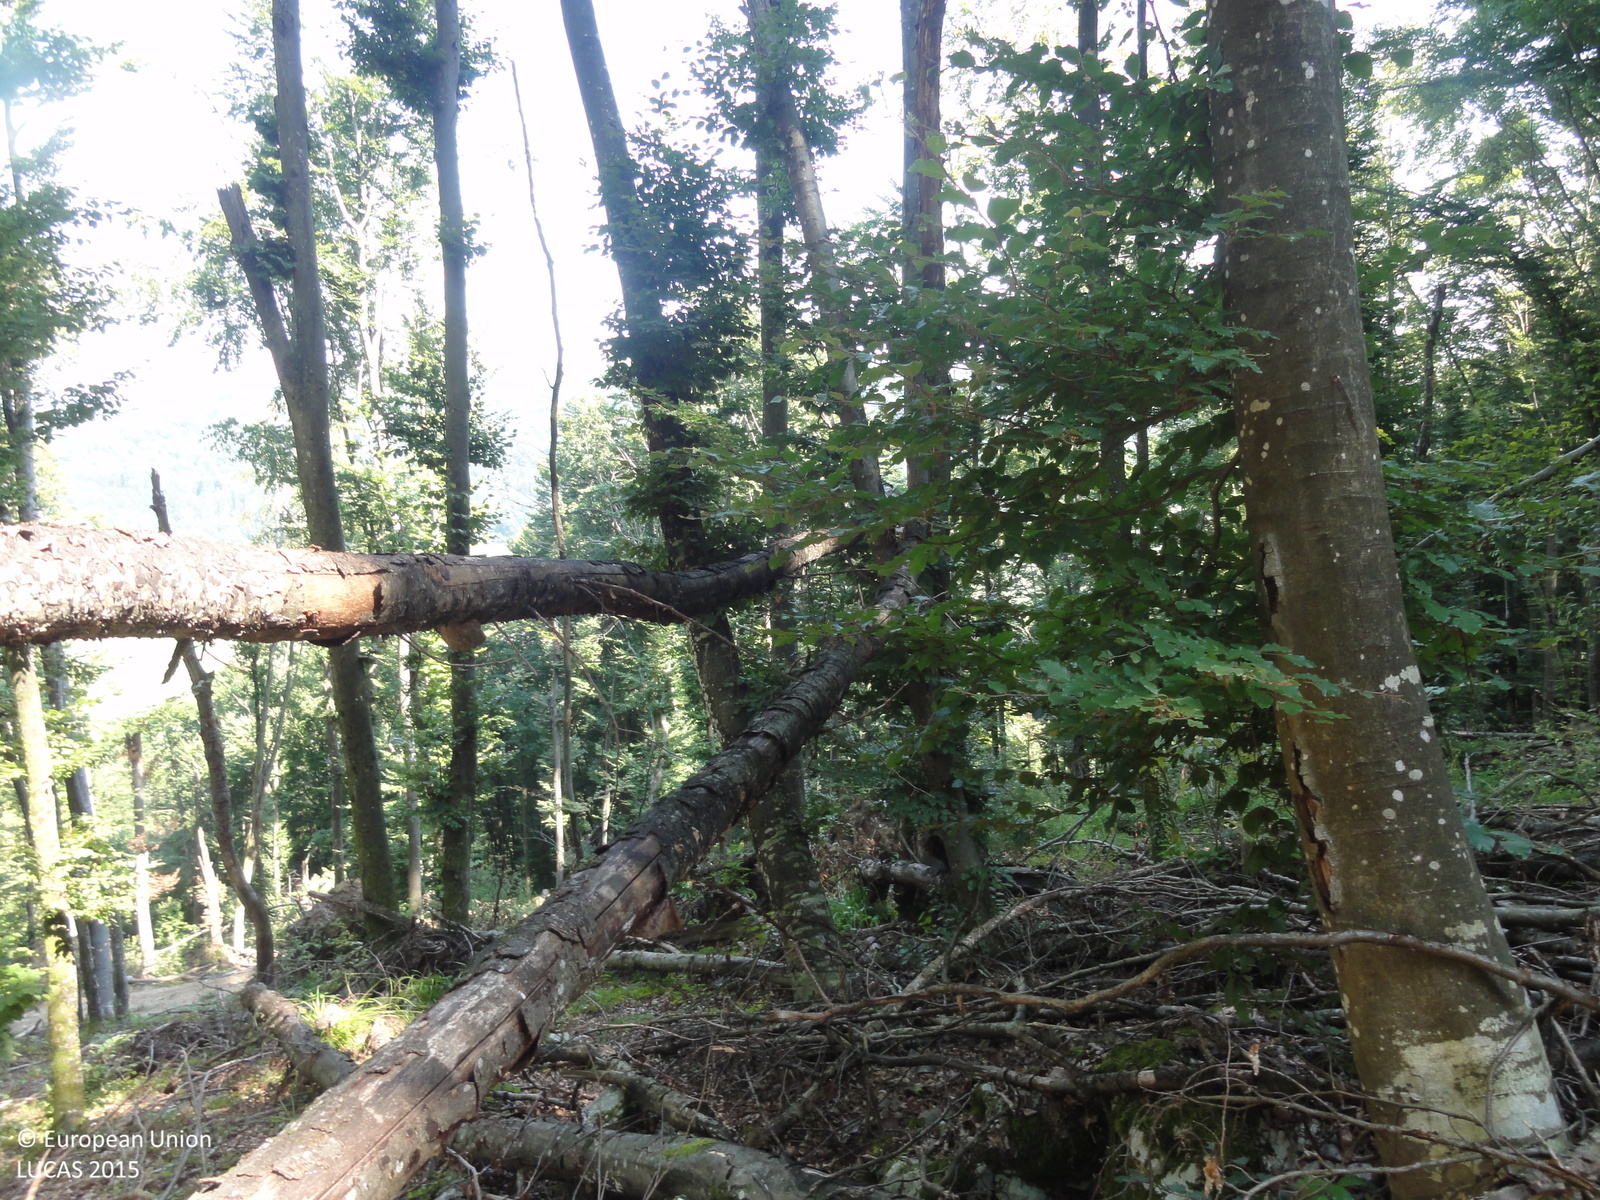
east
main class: Woodland
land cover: Broadleaved woodland
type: beech forest
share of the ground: > 75 %
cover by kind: broadleaved forest trees 80 %, herbaceous plants 15 %, consolidated bare surface 5 %
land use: Forestry
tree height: > 5 m
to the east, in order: Broadleaved woodland; Spontaneously vegetated surfaces; Broadleaved woodland; Tracks; Broadleaved woodland; Tracks; Broadleaved woodland
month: August
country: SI
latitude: 45.8538
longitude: 15.0320
